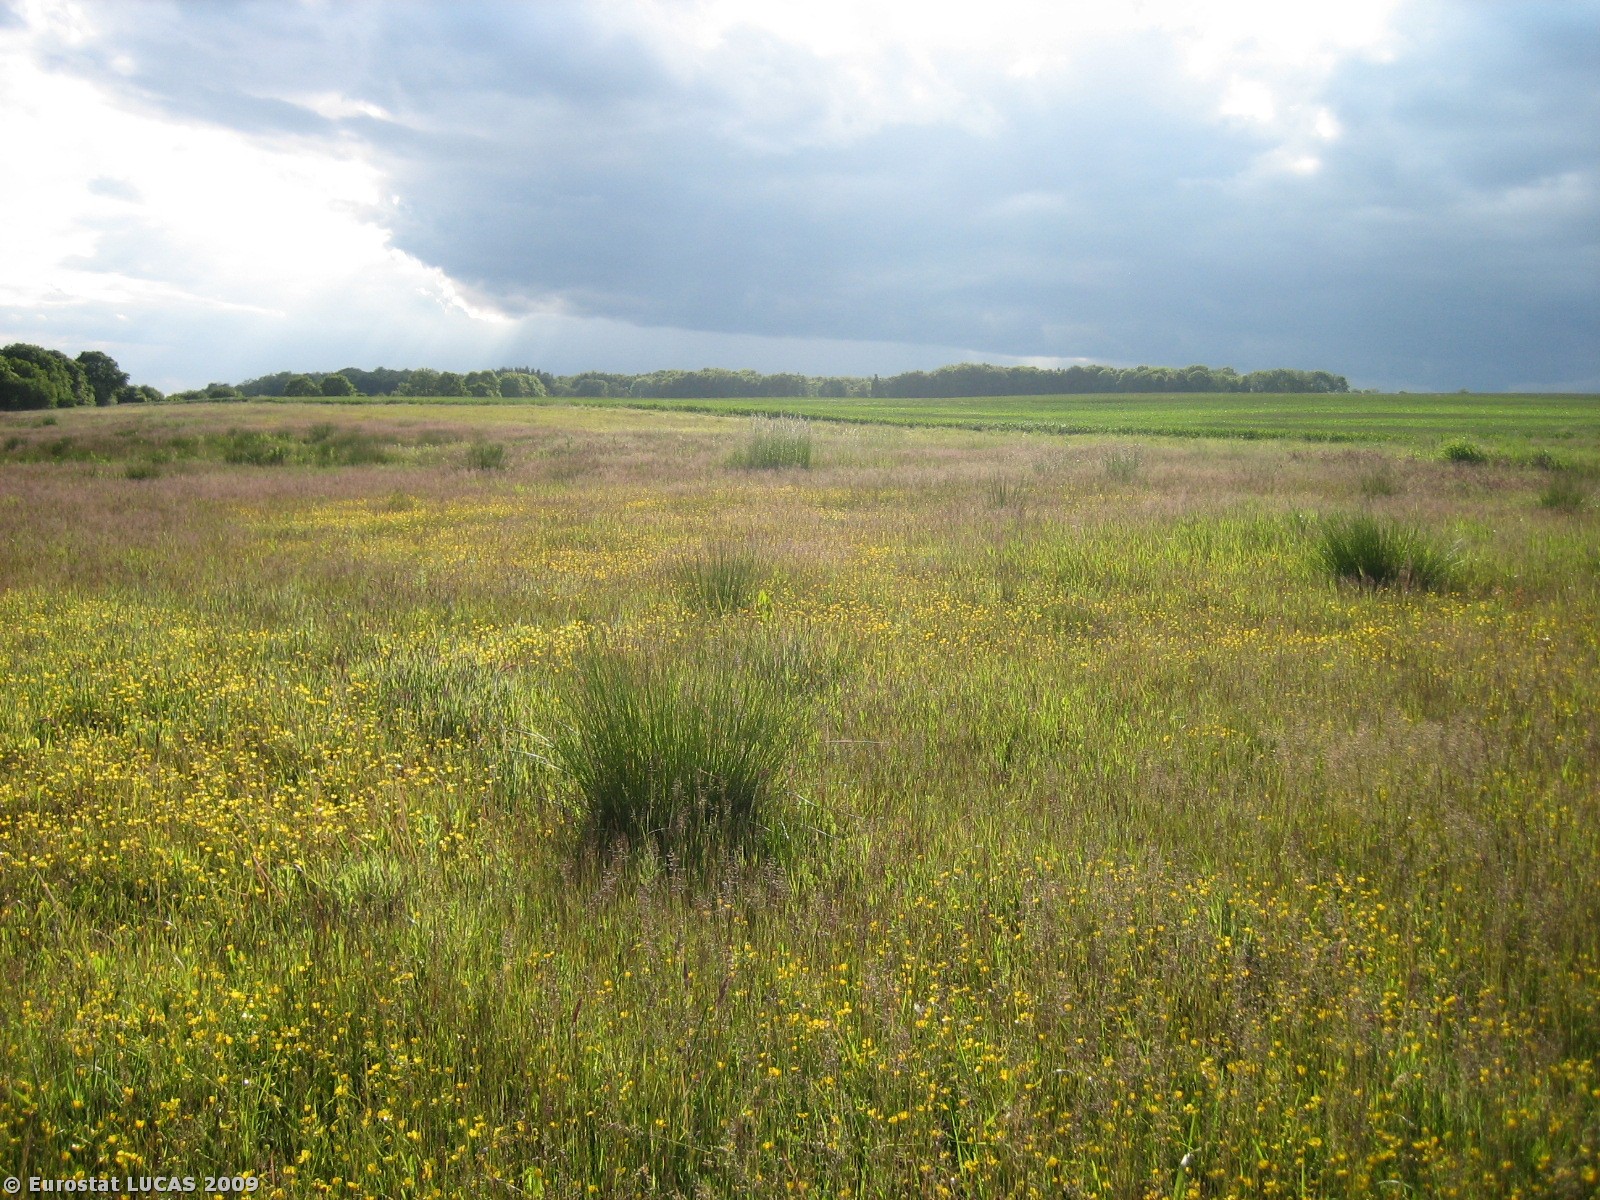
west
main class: Grassland
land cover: Grassland without tree/shrub cover
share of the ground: > 75 %
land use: Unused
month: June
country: DK
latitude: 56.1697
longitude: 9.9196
